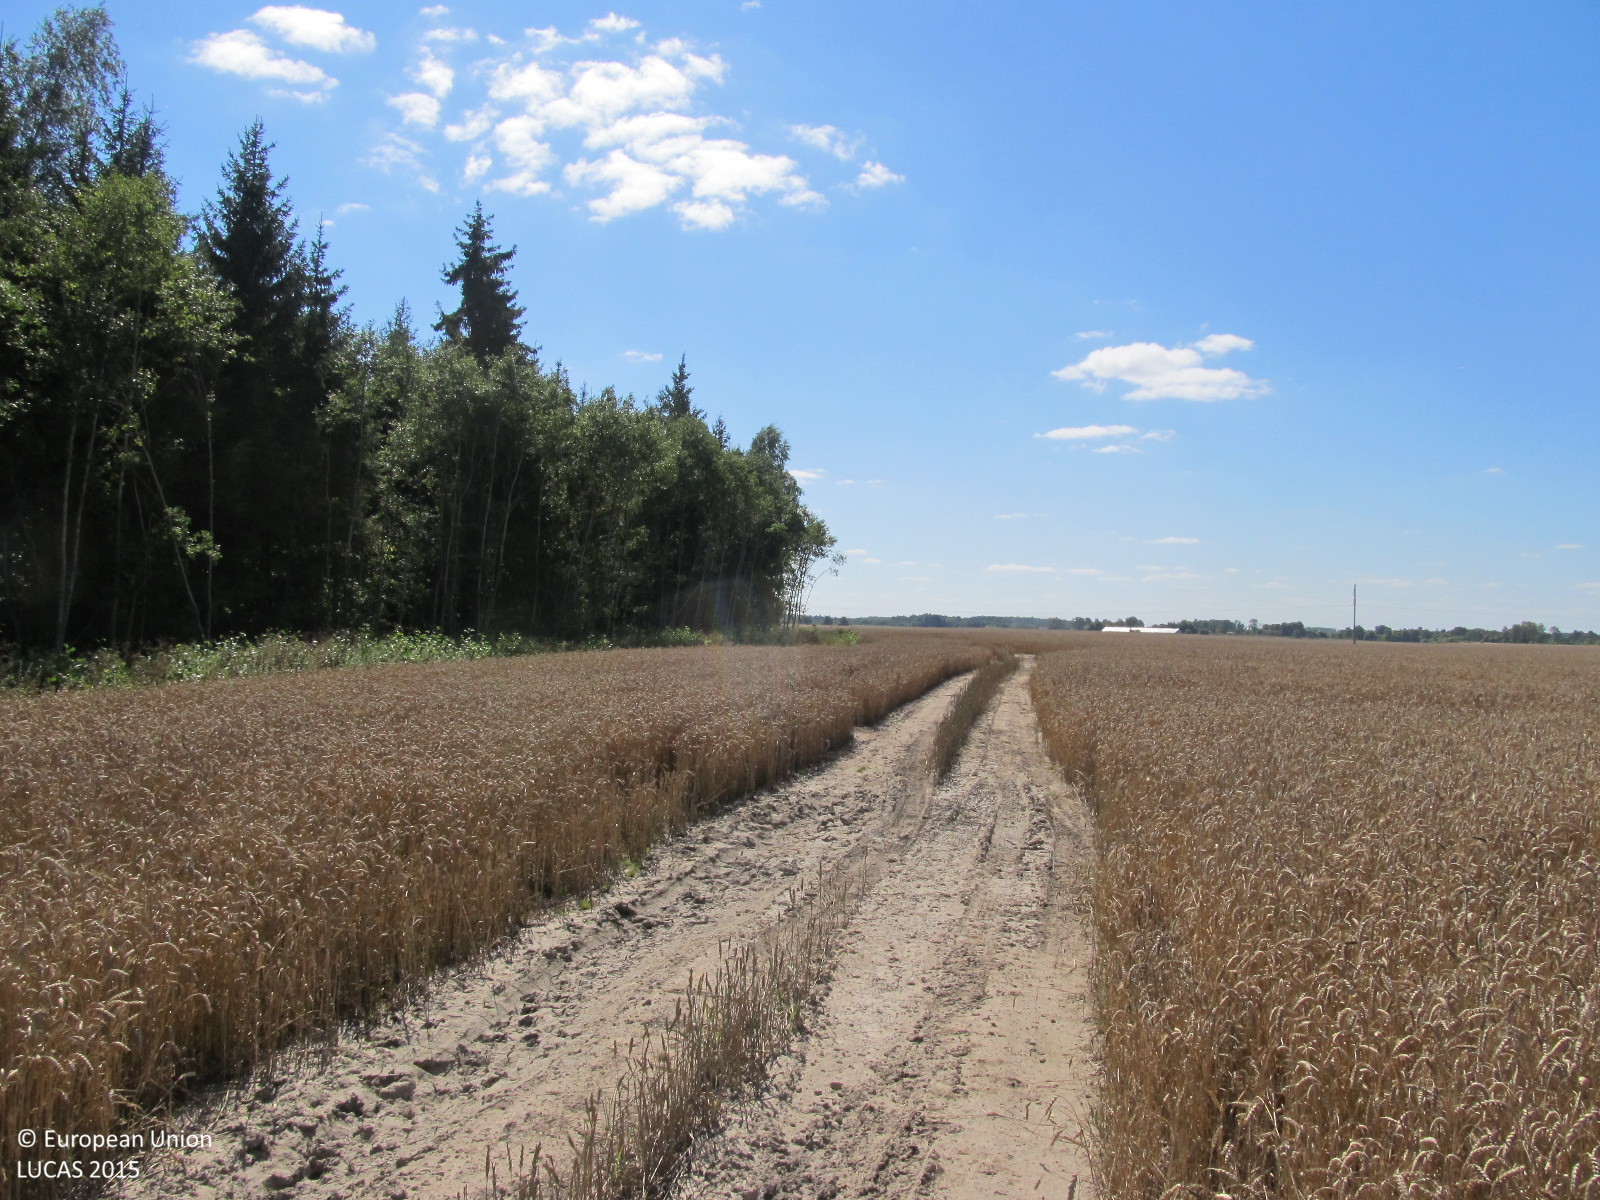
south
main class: Cropland
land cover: Common wheat
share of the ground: > 75 %
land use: Agriculture (excluding fallow land and kitchen gardens)
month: August
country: LT
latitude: 56.0829
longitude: 22.8724
